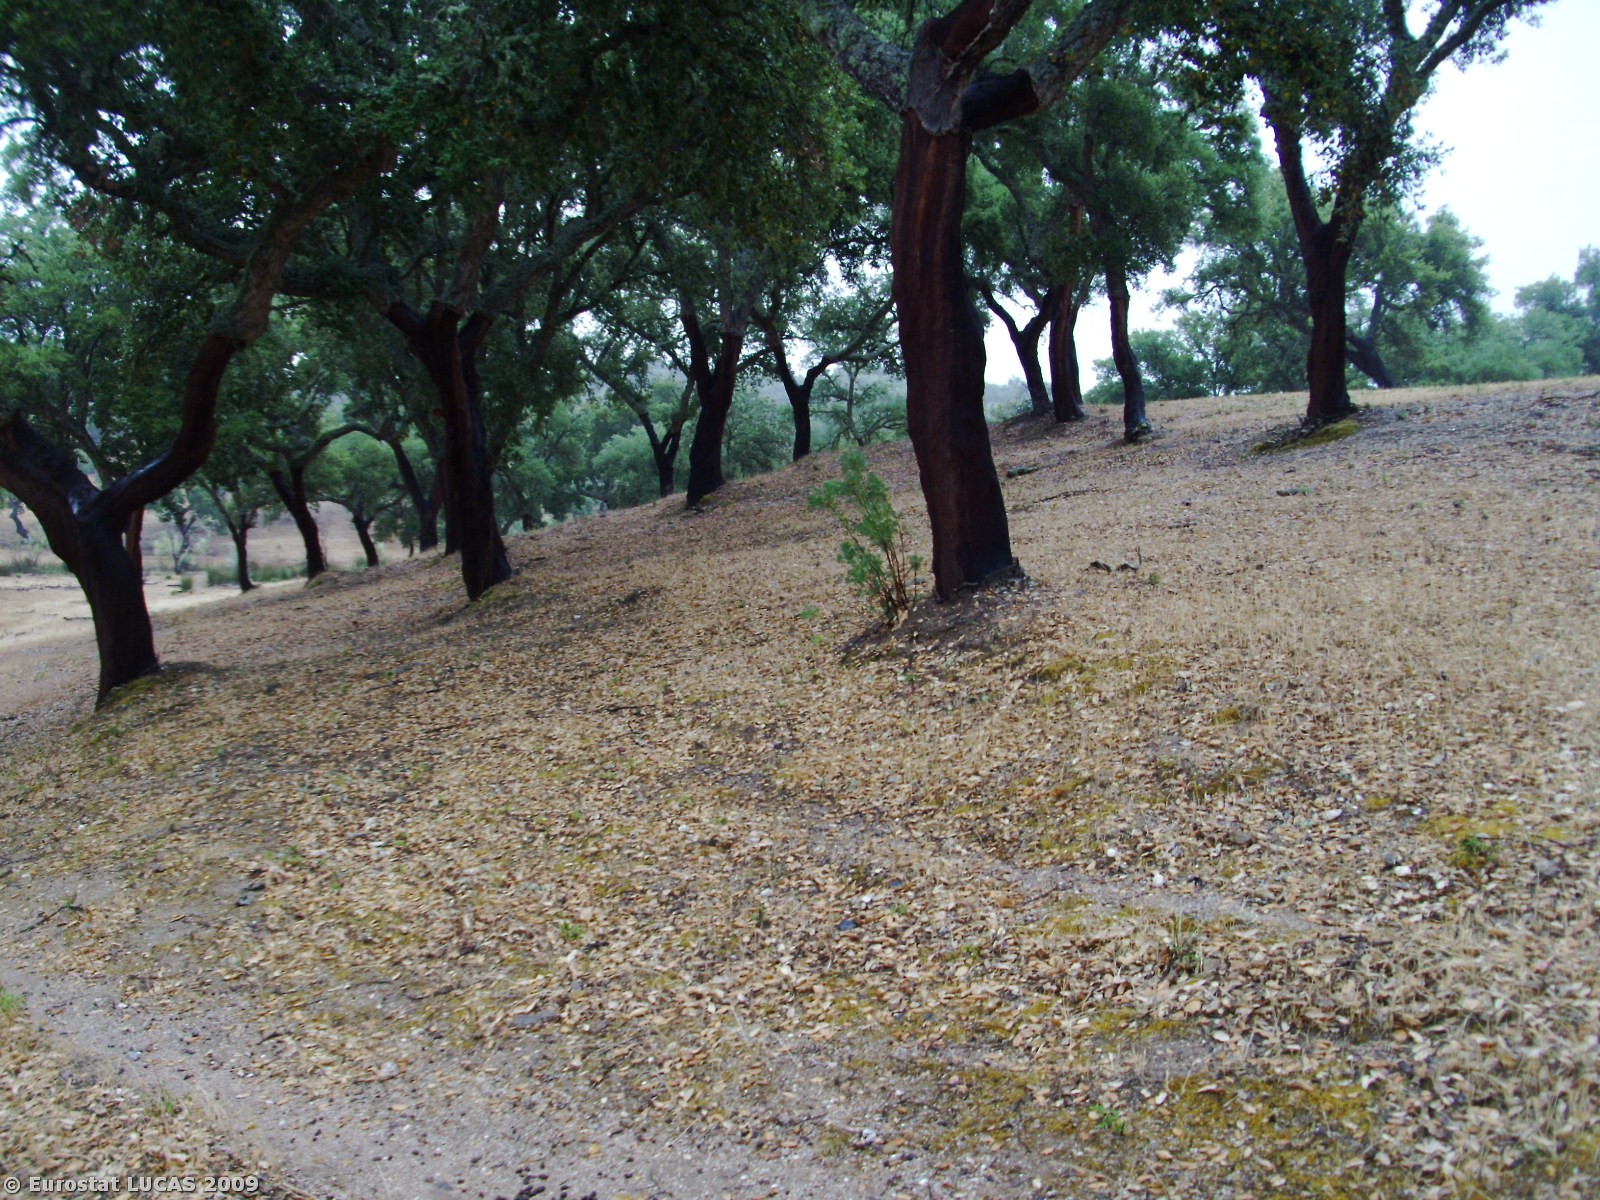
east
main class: Woodland
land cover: Broadleaved woodland
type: broadleaved evergreen forest
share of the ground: 50 - 75 %
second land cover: Bare land
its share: 25 - 50 %
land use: Forestry
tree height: > 5 m
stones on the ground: 25 - 50 %
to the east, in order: Broadleaved woodland; Bare land; Broadleaved woodland; Inland water bodies; Broadleaved woodland
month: June
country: PT
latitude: 39.7967
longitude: -7.2487
